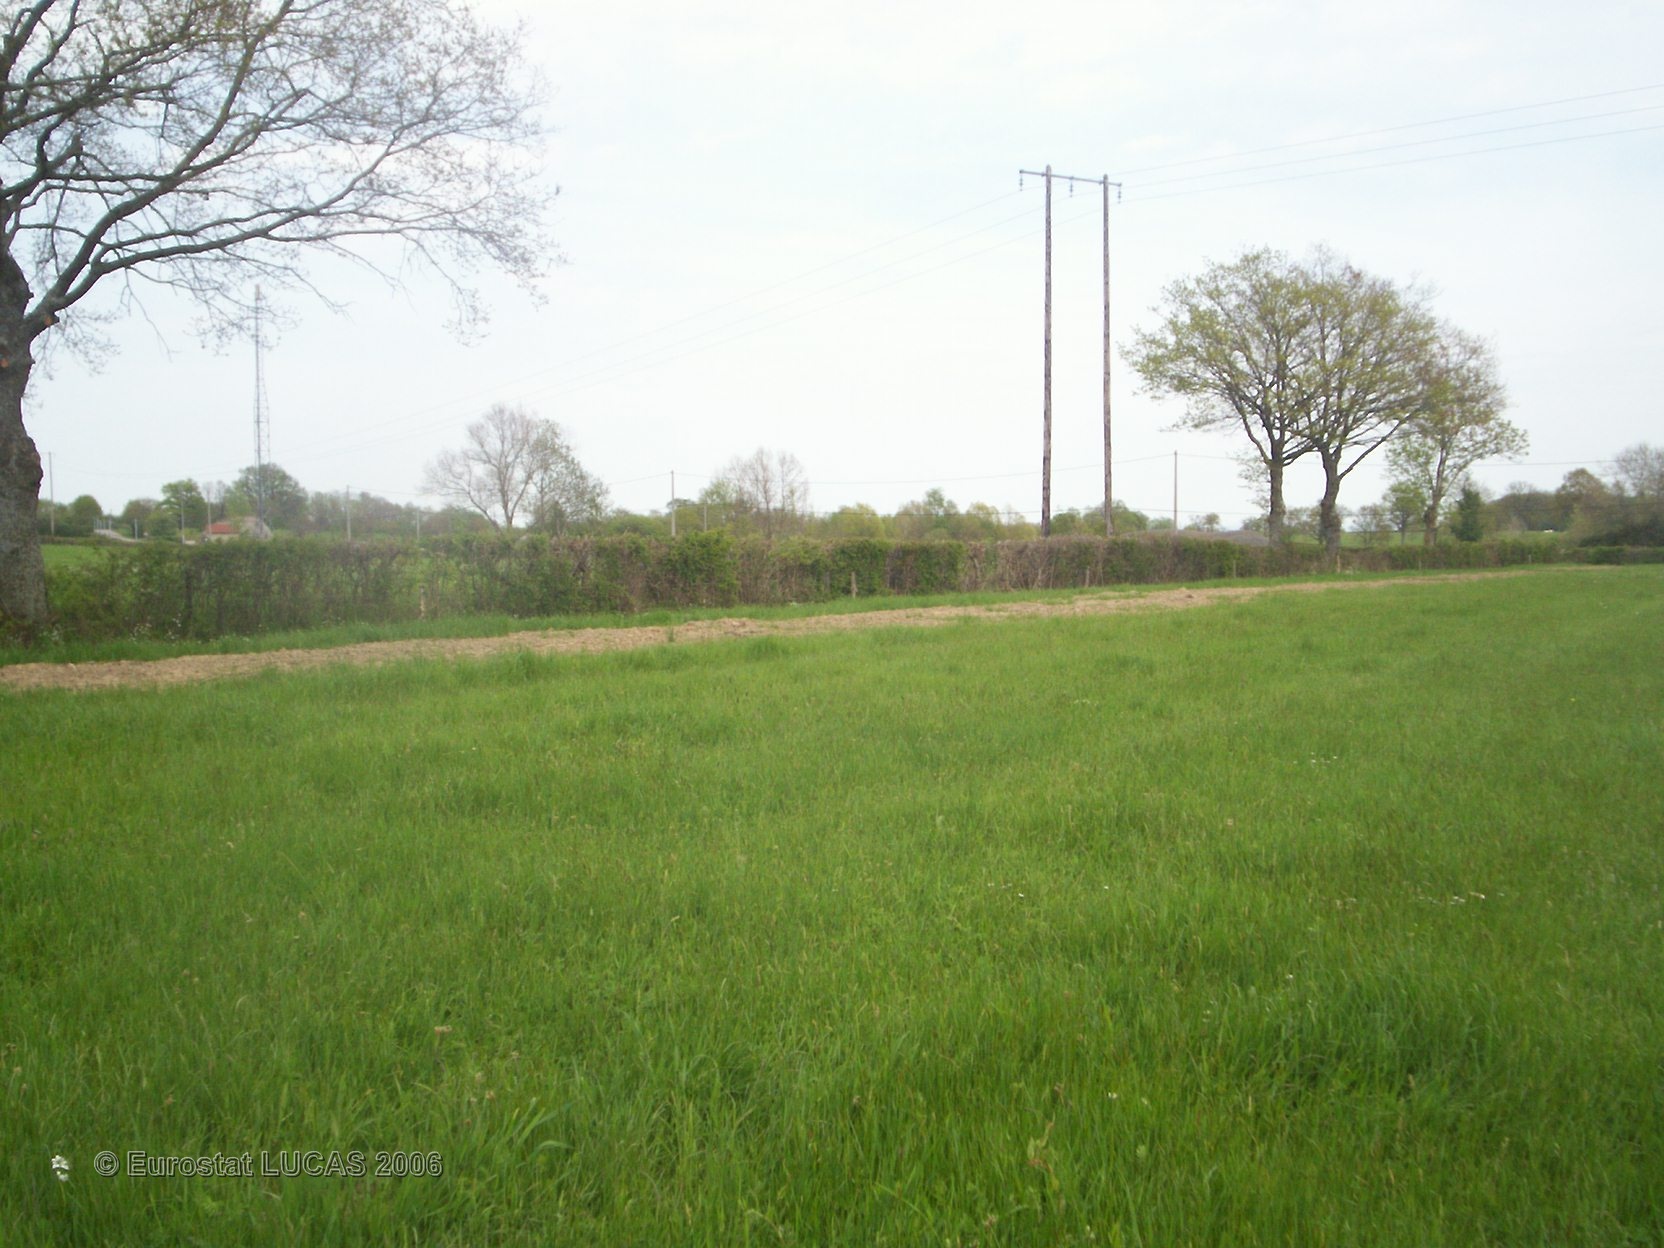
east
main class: Grassland
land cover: Grassland without tree/shrub cover
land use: Agriculture (excluding fallow land and kitchen gardens)
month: May
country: FR
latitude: 46.4380
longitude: 3.1387
